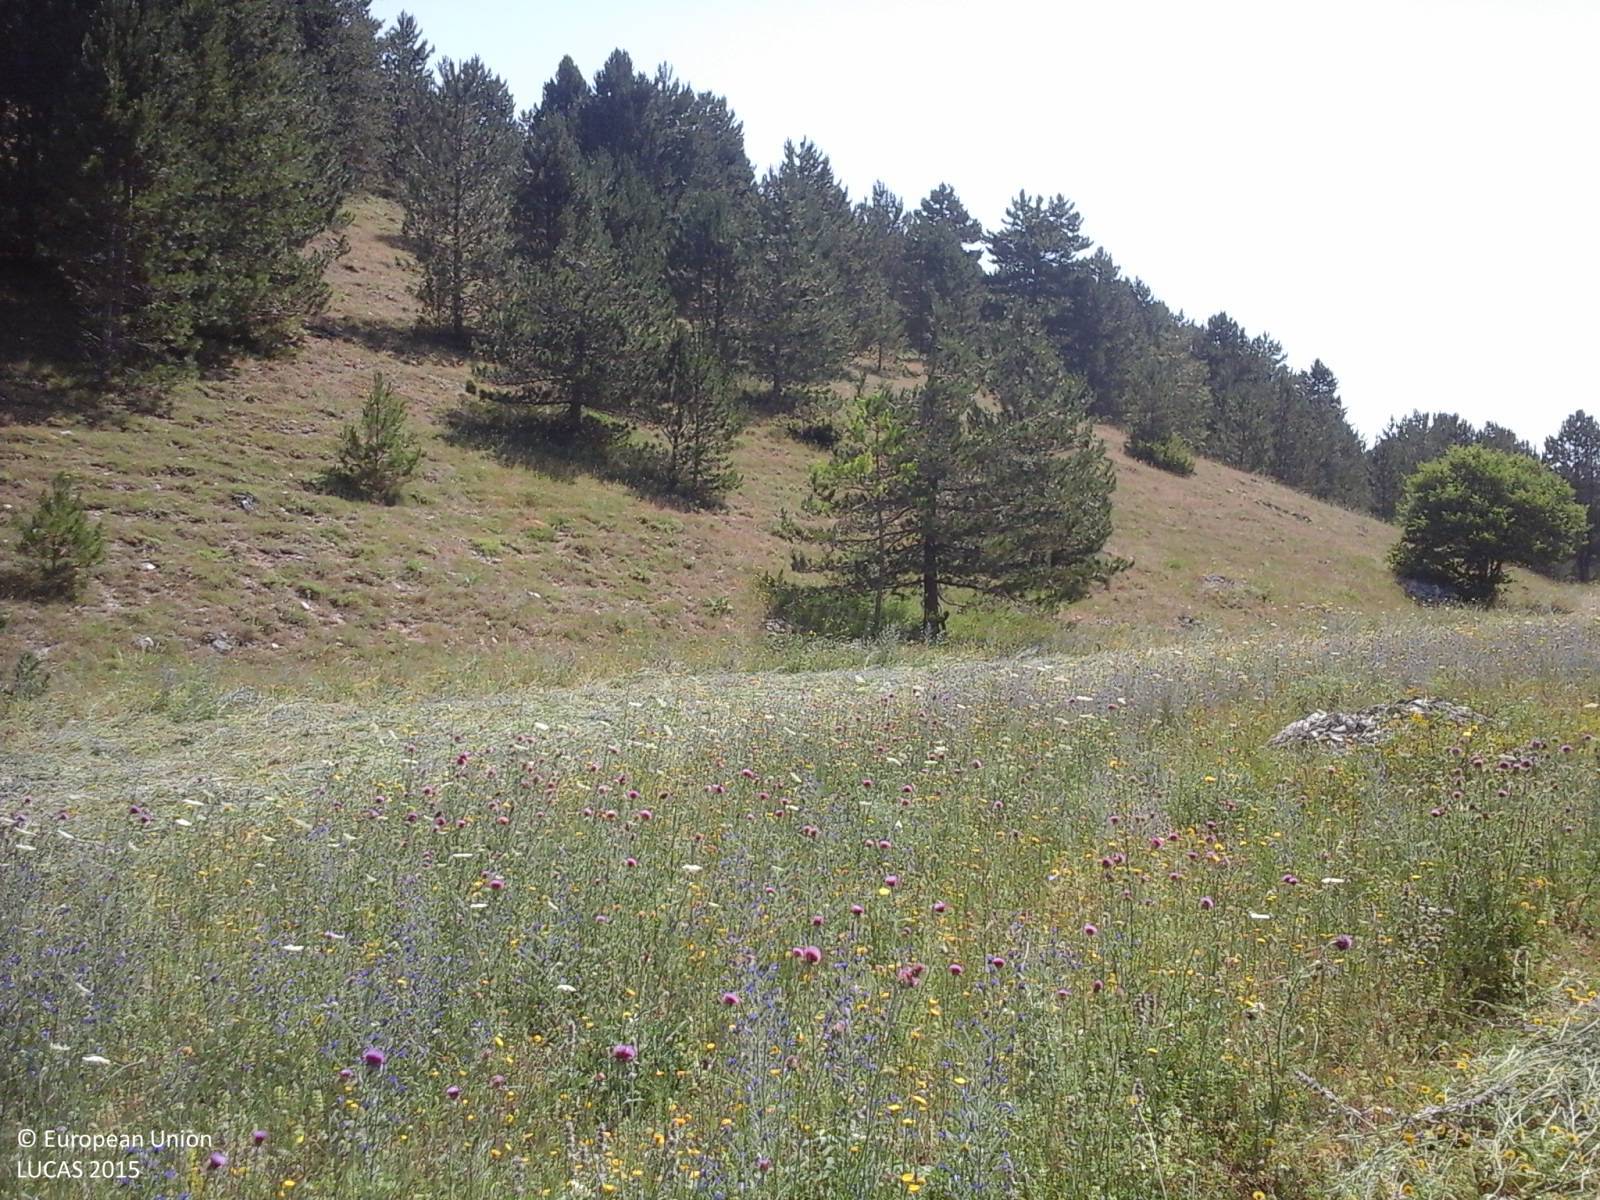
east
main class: Grassland
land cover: Grassland without tree/shrub cover
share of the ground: > 75 %
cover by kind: herbaceous plants 100 %
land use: Agriculture (excluding fallow land and kitchen gardens)
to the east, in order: Grassland without tree/shrub cover; Pine dominated coniferous woodland; Grassland without tree/shrub cover
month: July
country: IT
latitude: 42.4161
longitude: 13.4040
